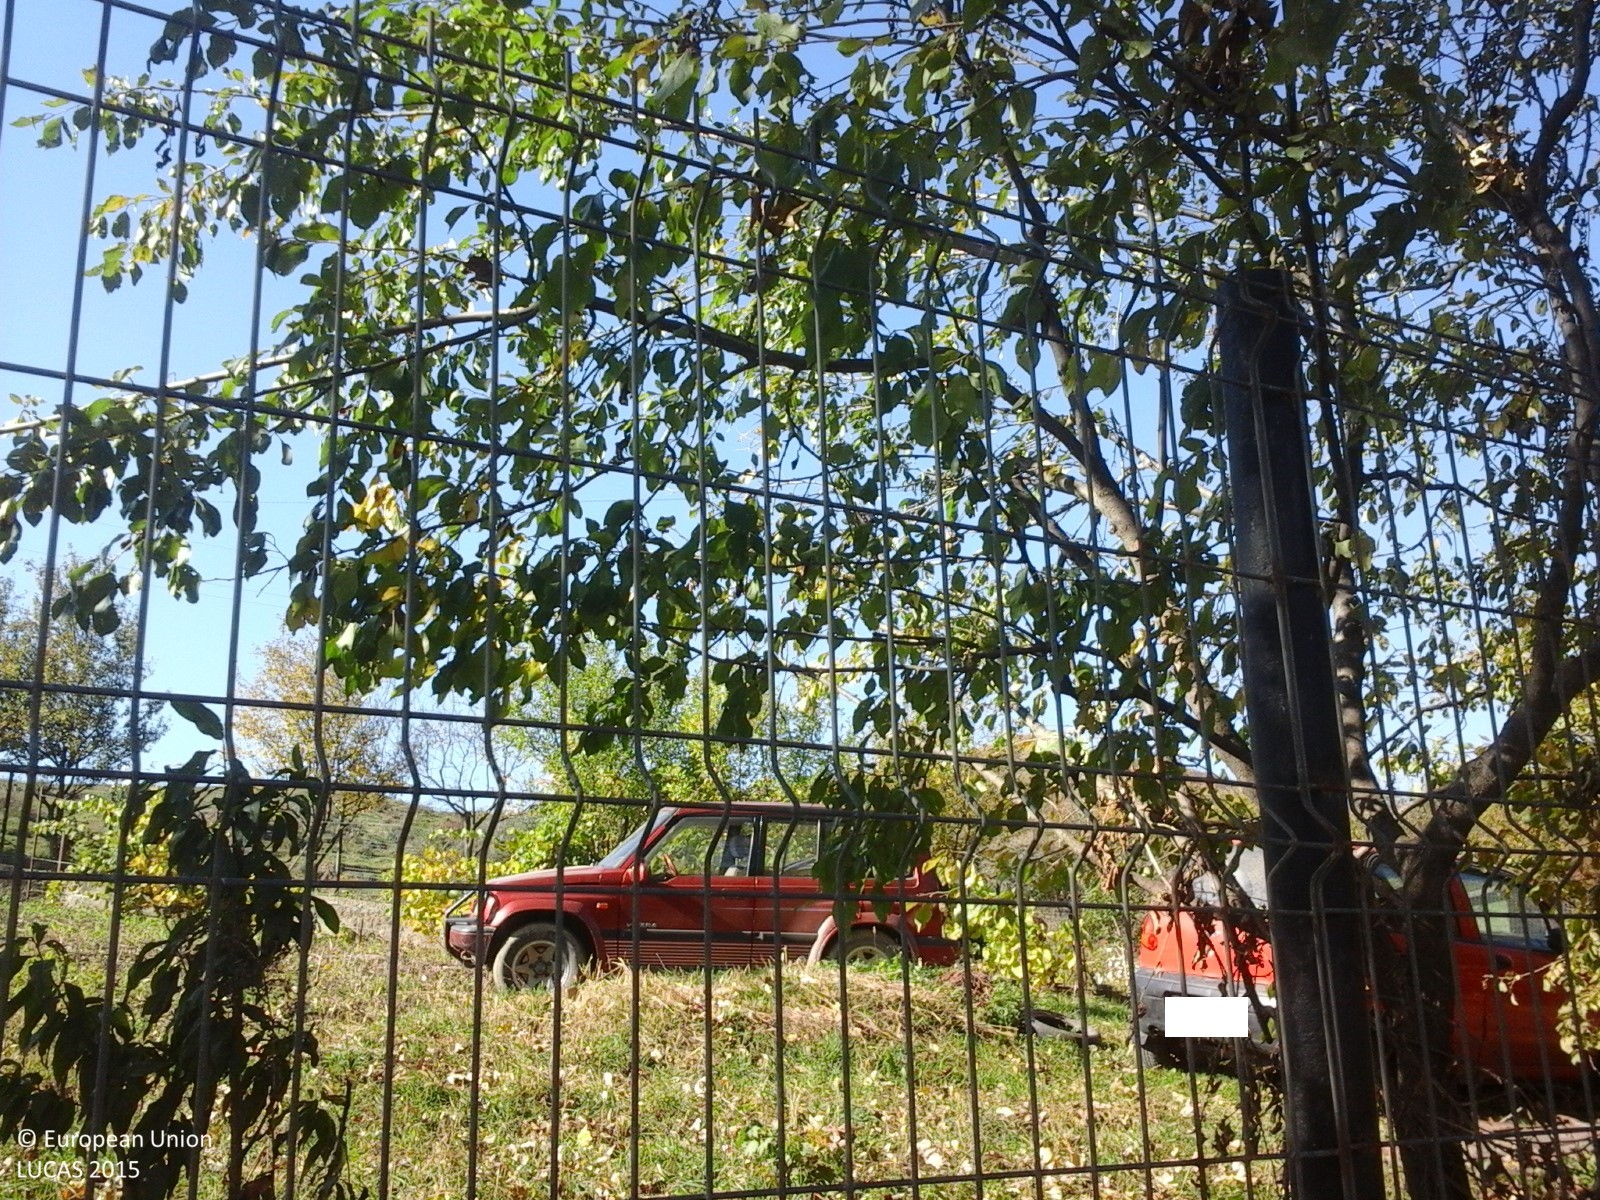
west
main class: Grassland
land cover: Grassland without tree/shrub cover
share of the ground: > 75 %
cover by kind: herbaceous plants 100 %
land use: Residential
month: October
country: RO
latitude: 45.4223
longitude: 26.5222
